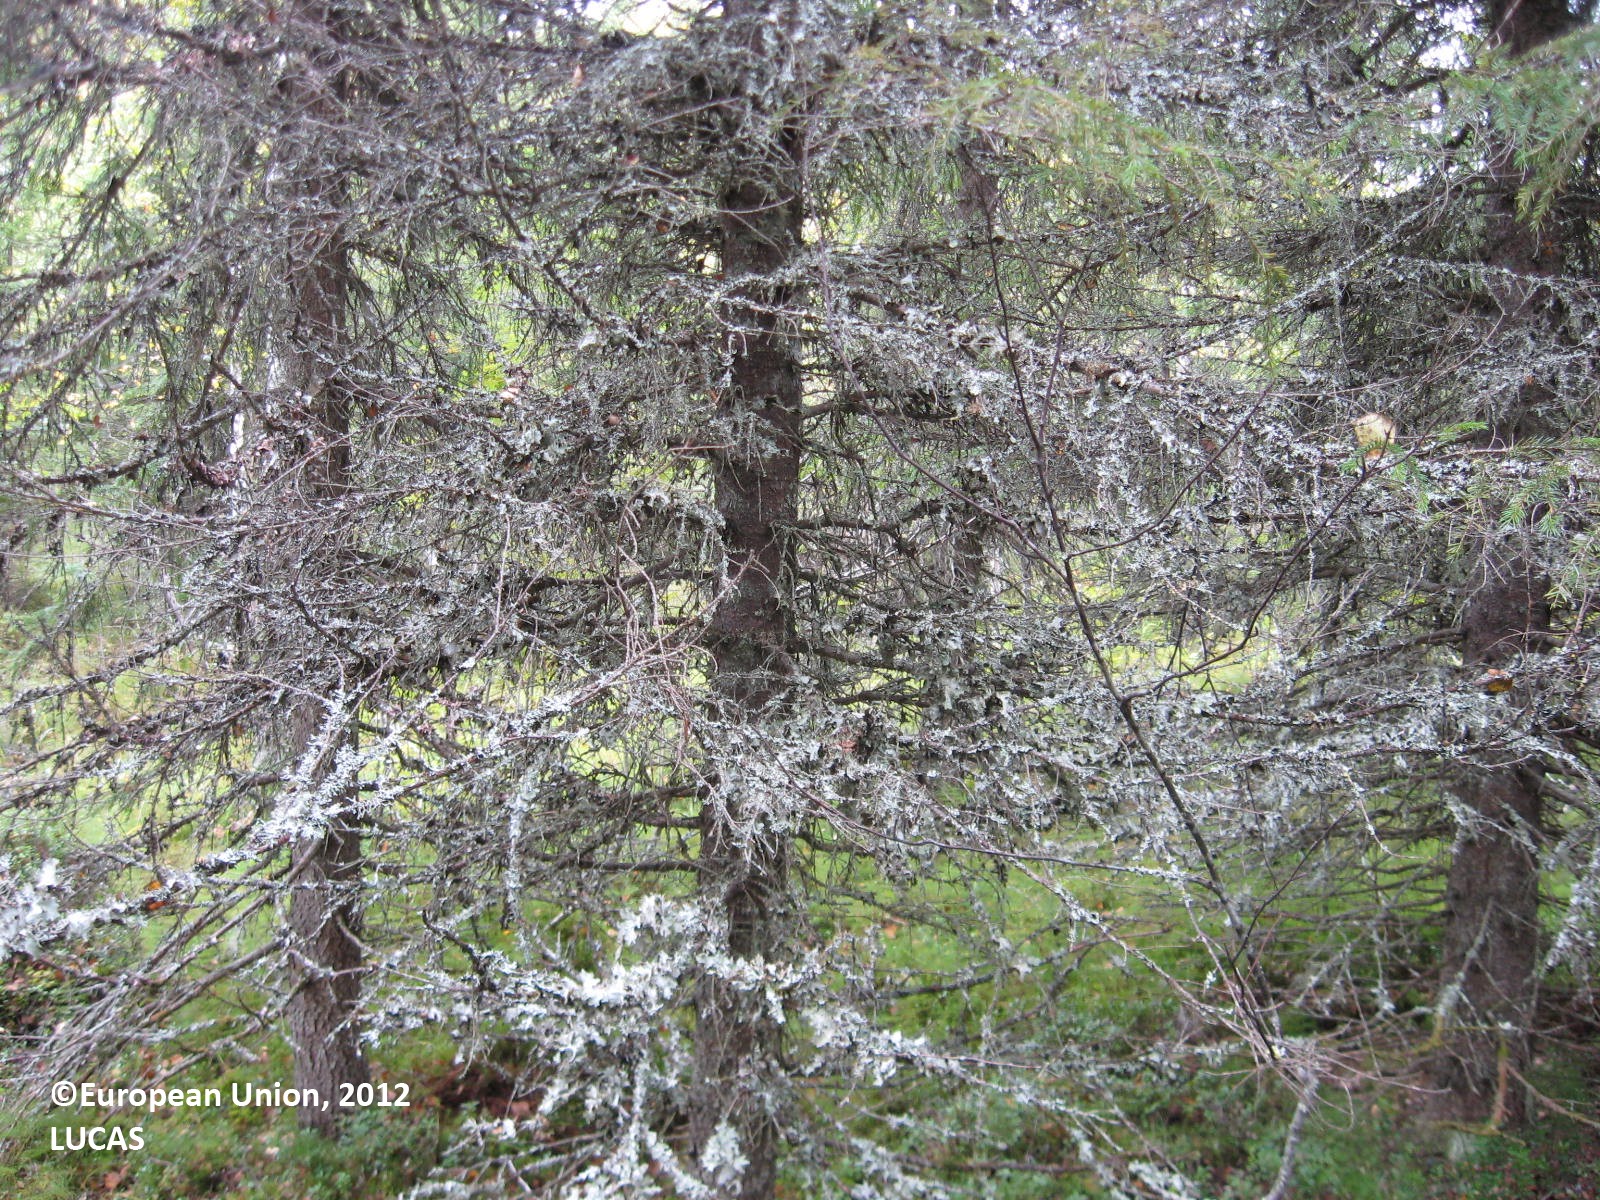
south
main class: Woodland
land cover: Other mixed woodland
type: boreal forest
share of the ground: 50 - 75 %
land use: Forestry
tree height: > 5 m
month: August
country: FI
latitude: 63.7686
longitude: 29.0445
